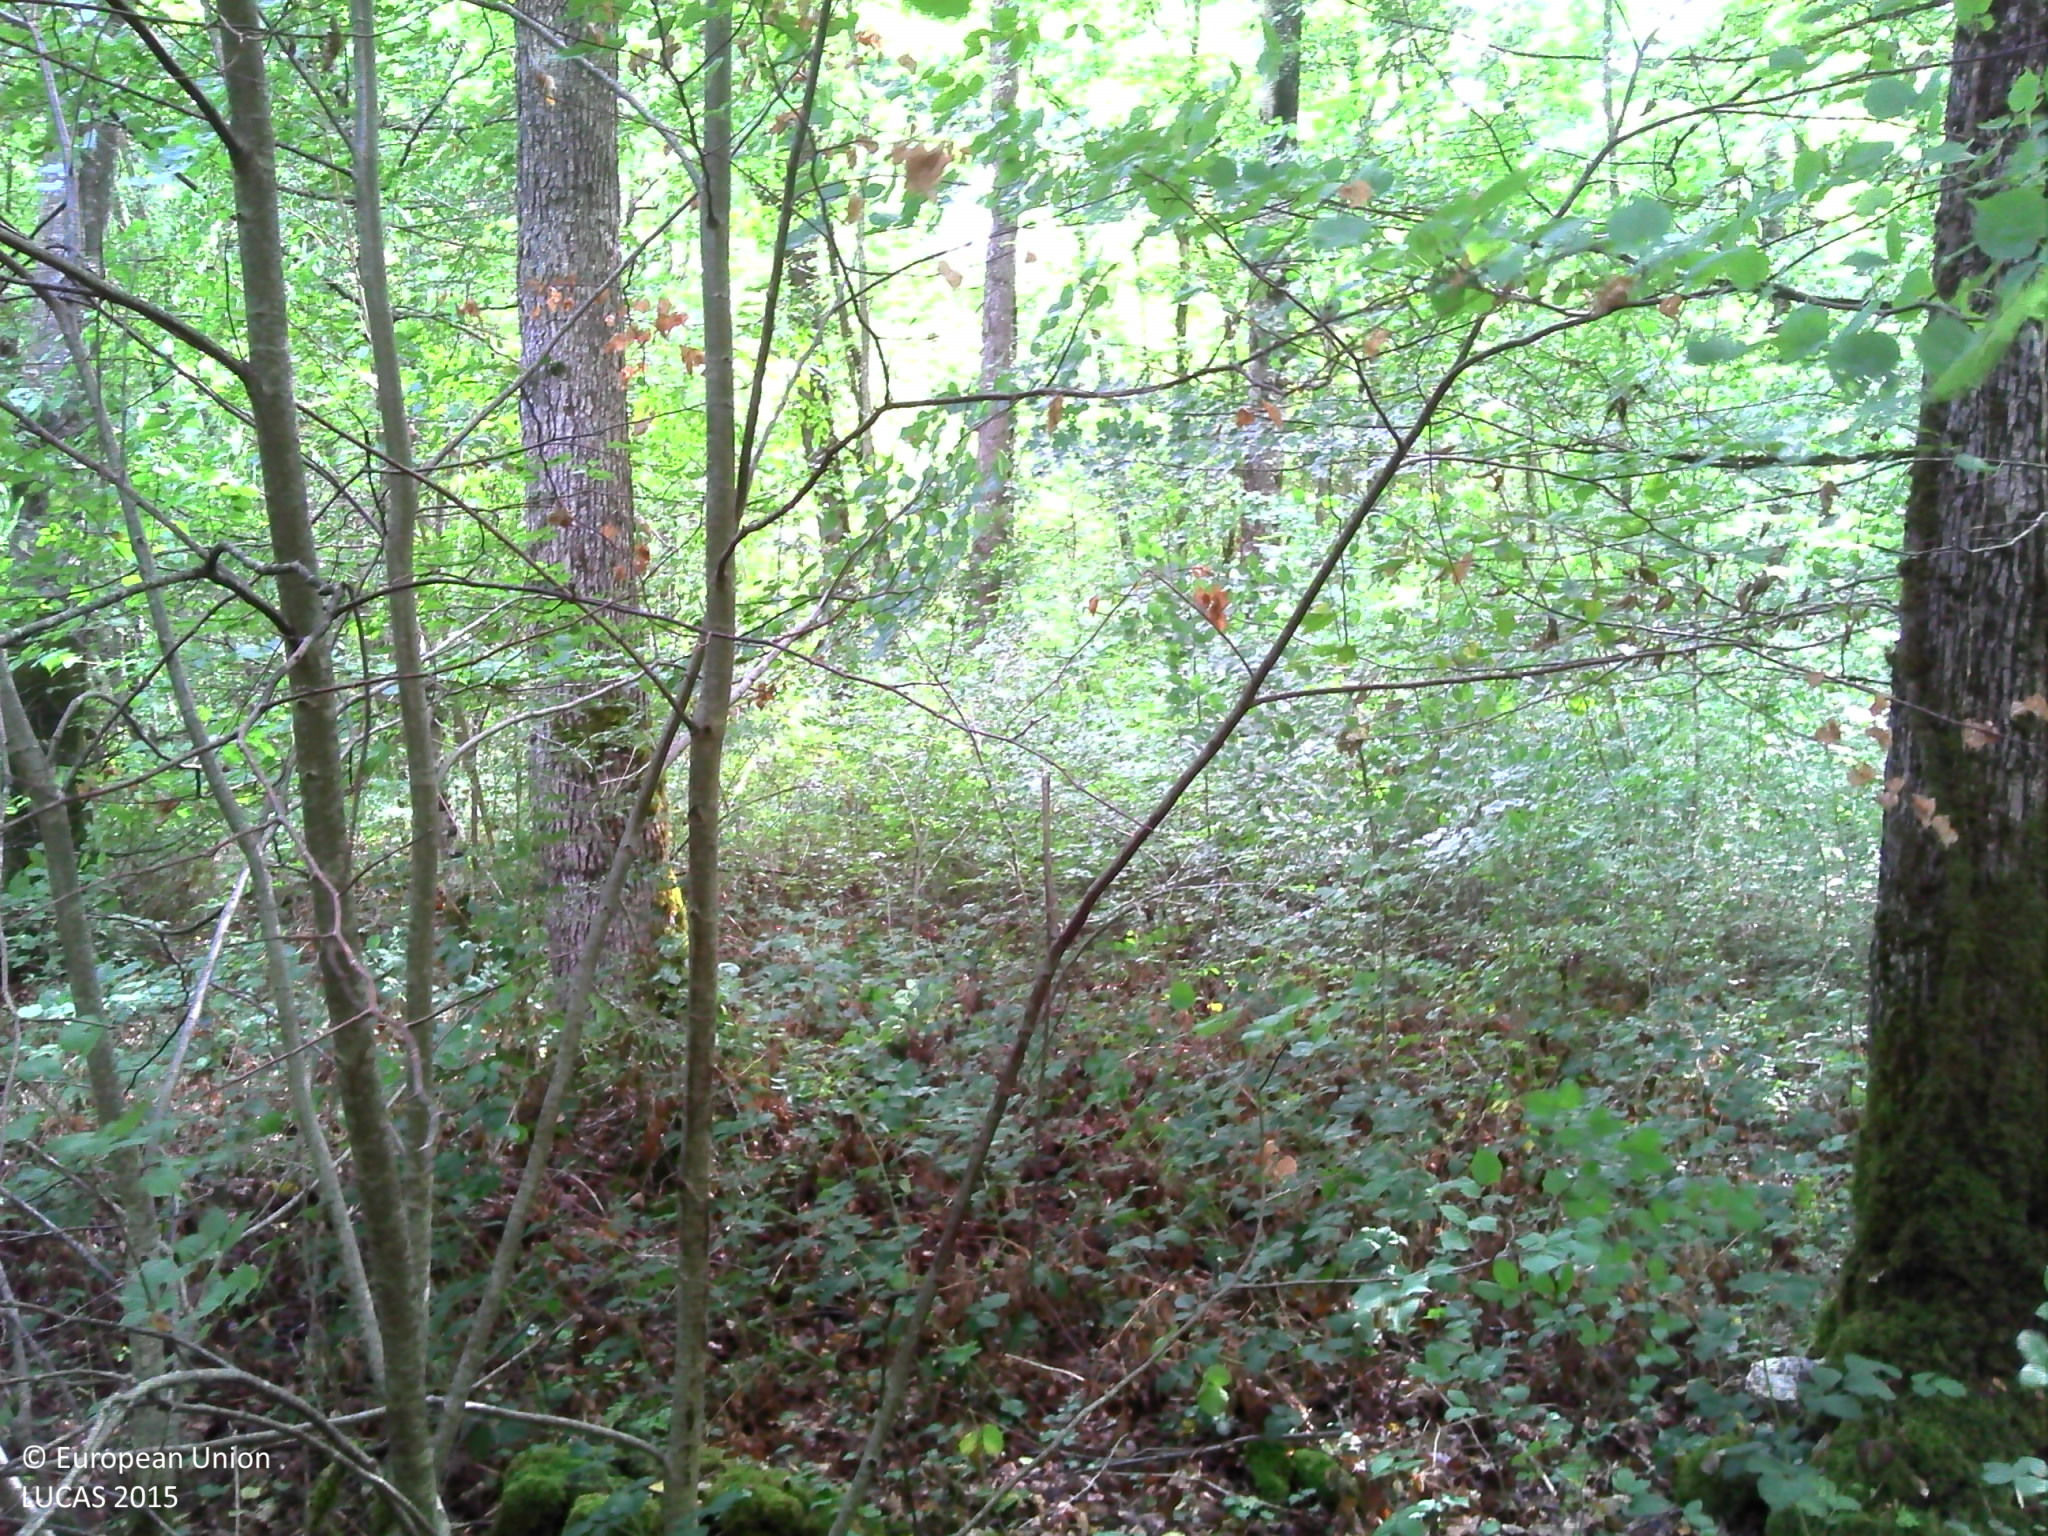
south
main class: Woodland
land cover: Broadleaved woodland
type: mesophytic deciduous forest
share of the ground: > 75 %
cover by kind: broadleaved forest trees 85 %, shrubs 5 %, herbaceous plants 5 %, lichens and mosses 5 %
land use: Forestry
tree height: > 5 m
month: August
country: FR
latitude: 47.9035
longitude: 4.8218
